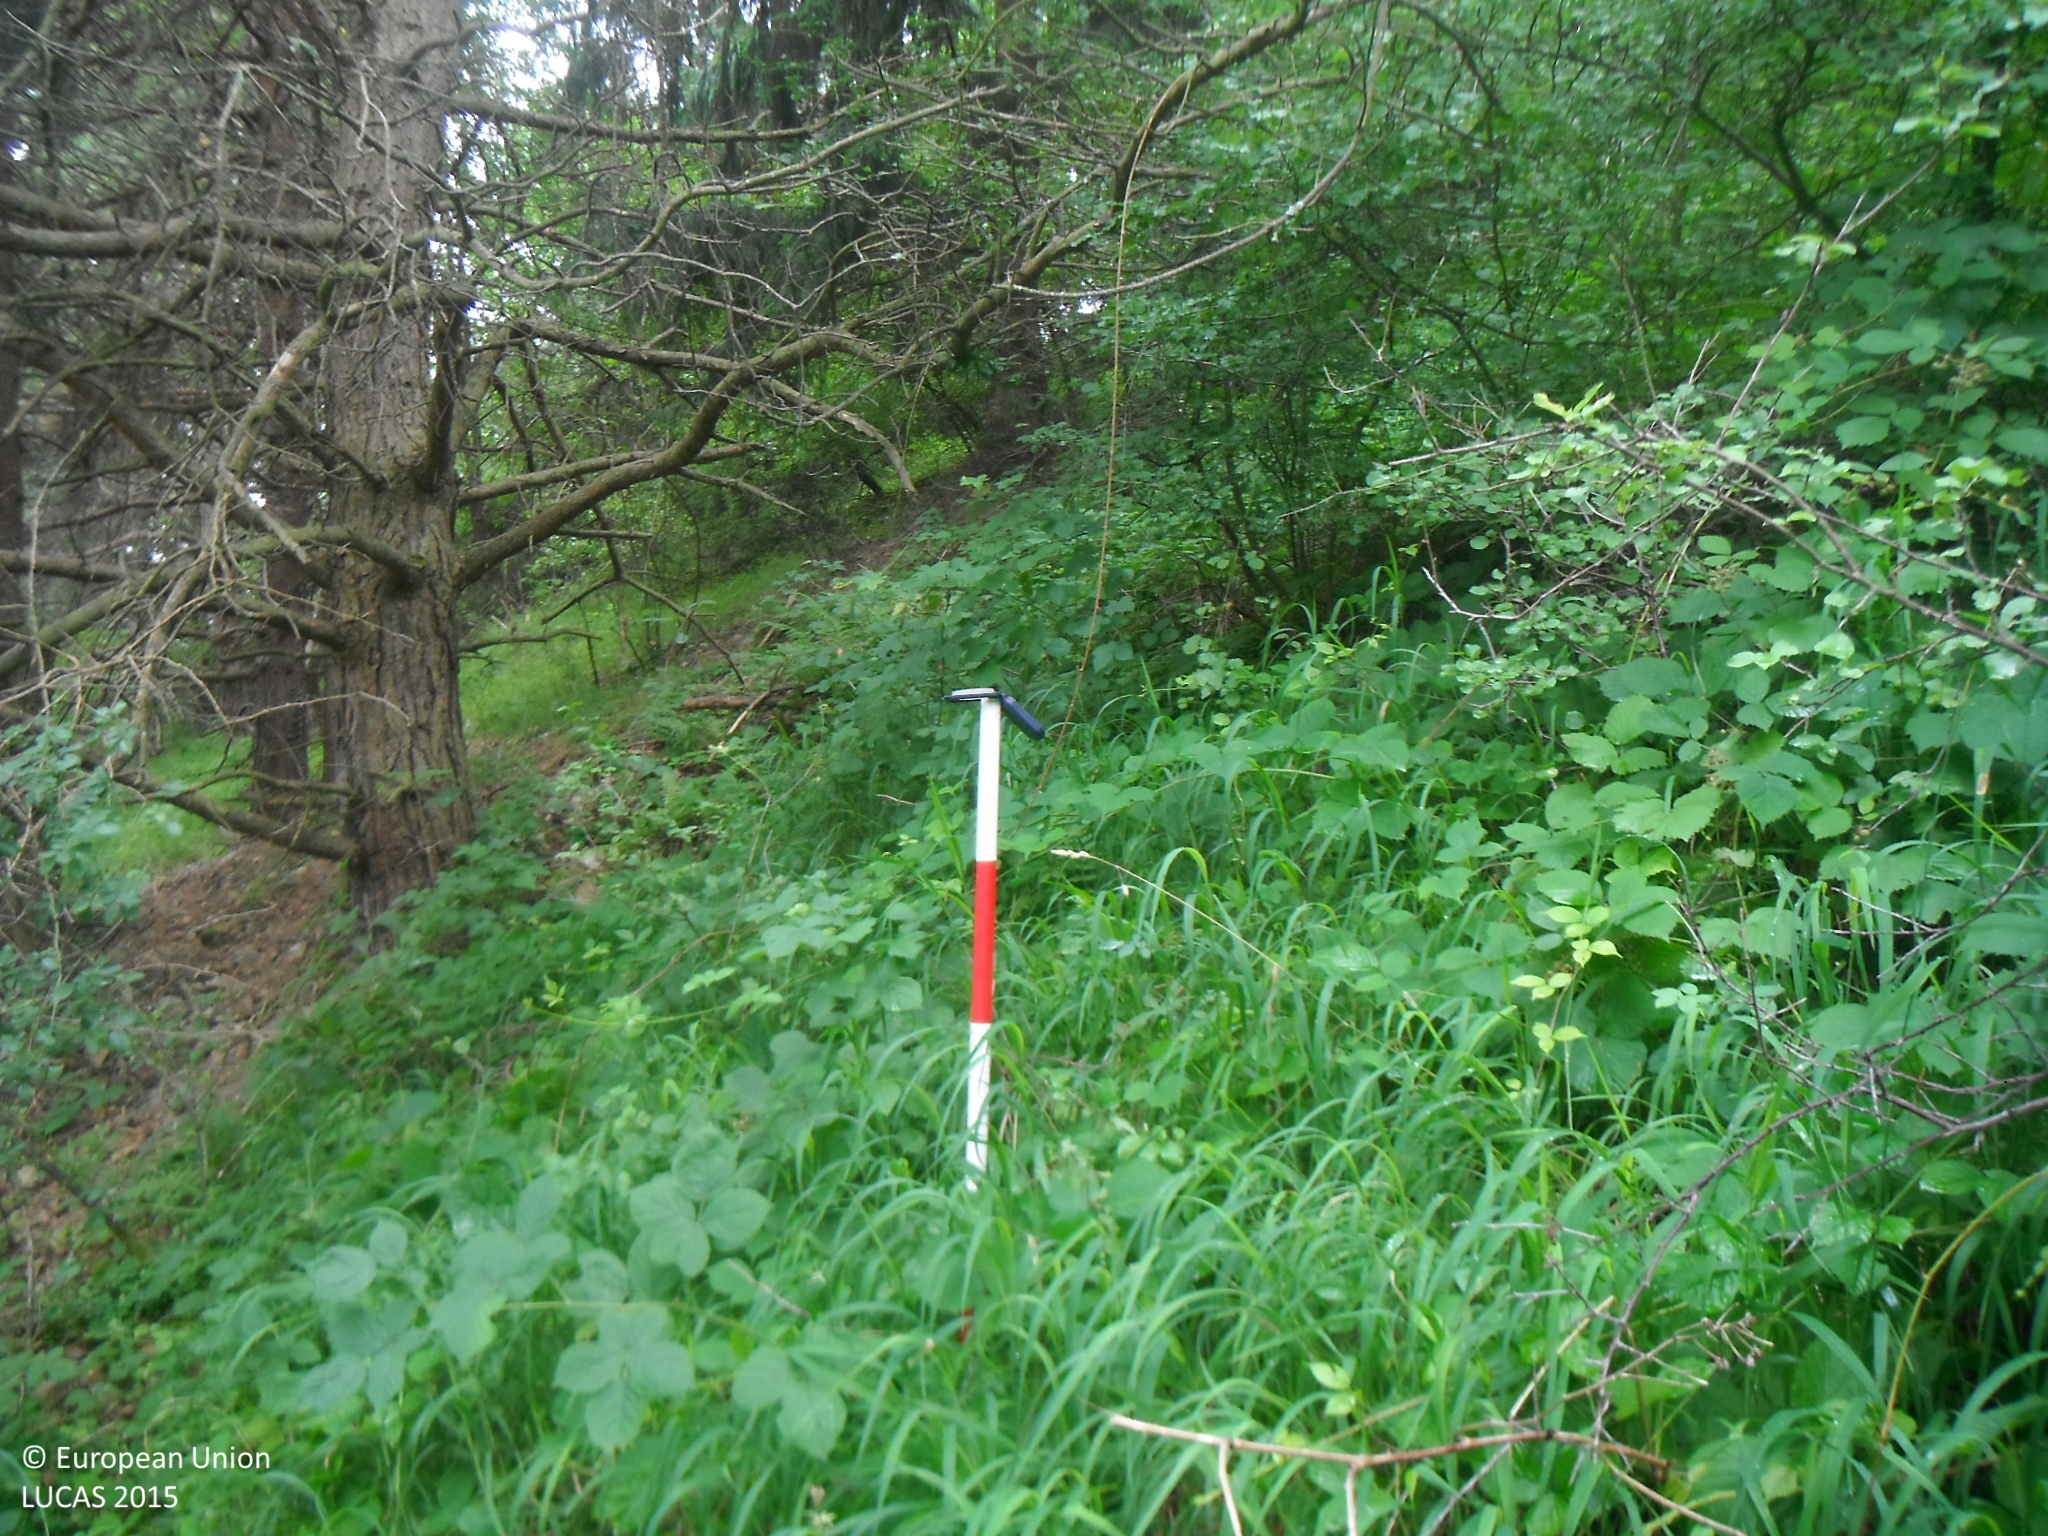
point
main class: Woodland
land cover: Pine dominated coniferous woodland
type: alpine coniferous forest
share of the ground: > 75 %
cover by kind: coniferous forest trees 75 %, herbaceous plants 15 %, shrubs 10 %
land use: Forestry
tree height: > 5 m
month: July
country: SK
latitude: 49.2403
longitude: 18.4097
